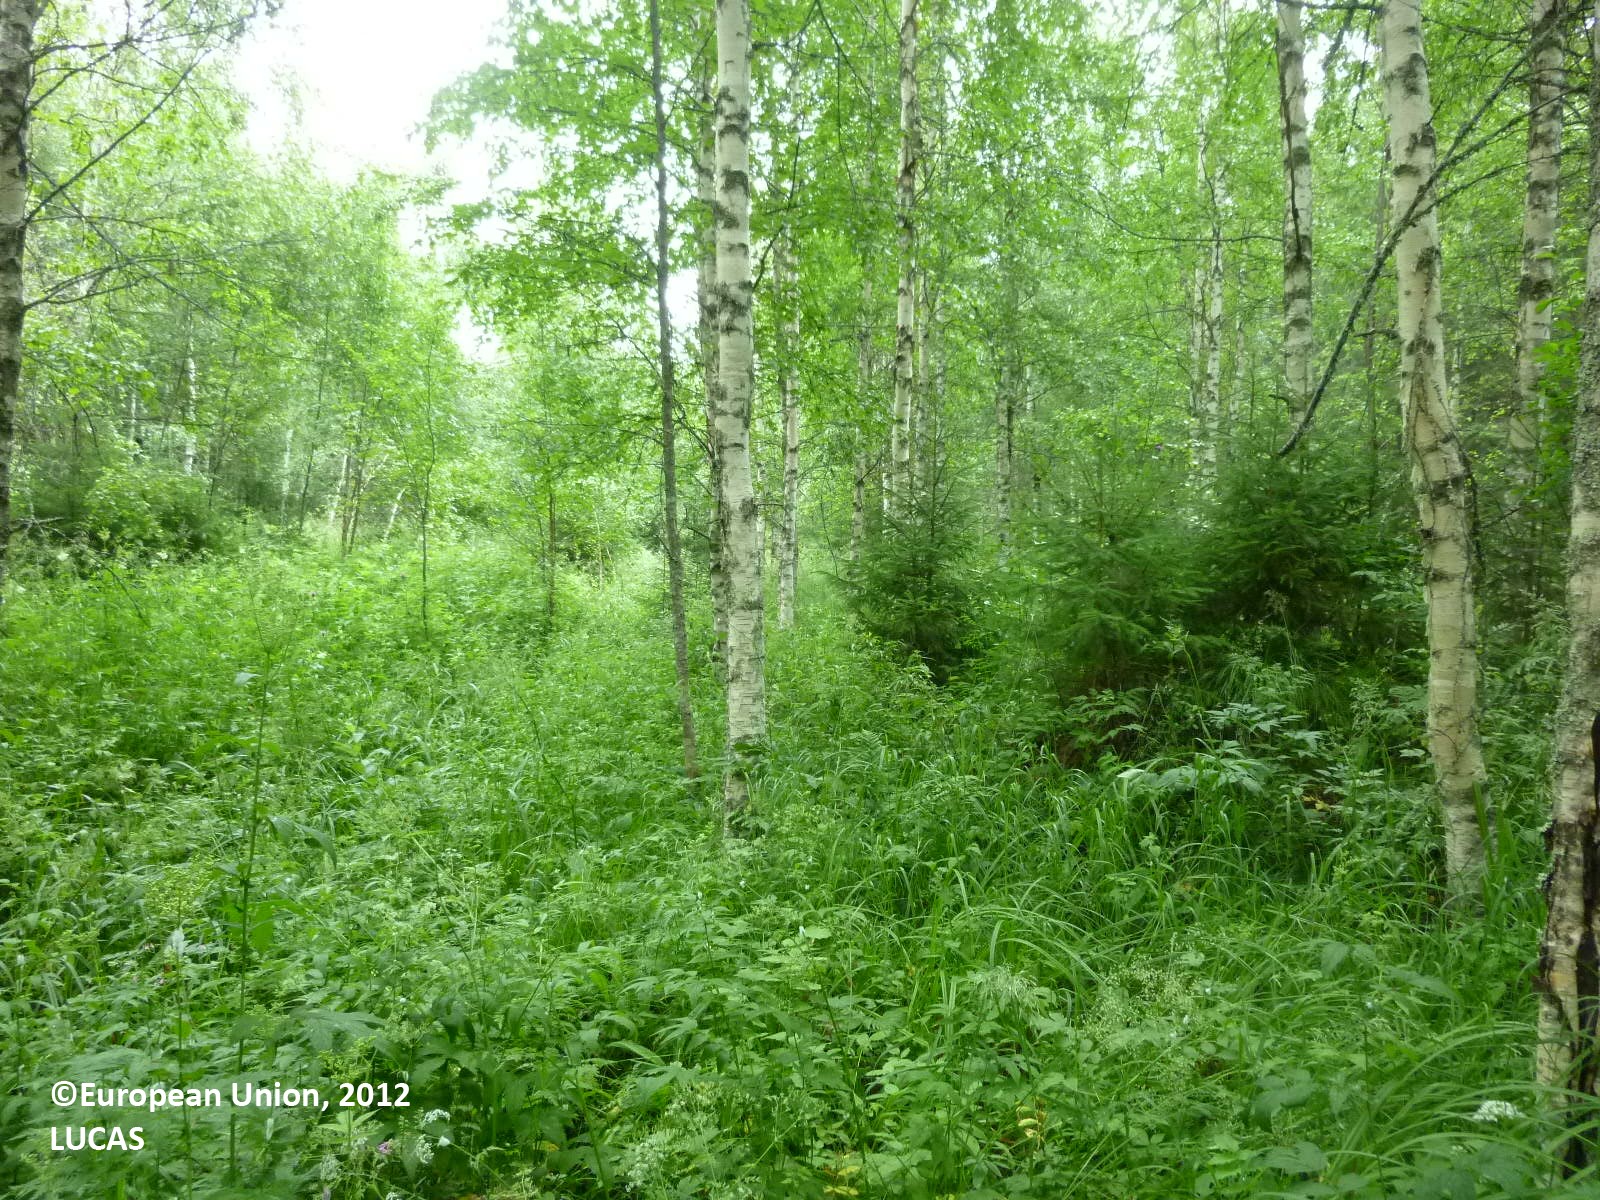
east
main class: Woodland
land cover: Broadleaved woodland
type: boreal forest
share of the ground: > 75 %
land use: Forestry
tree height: > 5 m
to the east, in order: Broadleaved woodland; Ditches and canals; Broadleaved woodland; Tracks; Ditches and canals; Broadleaved woodland; Ditches and canals; Pine dominated coniferous woodland; Ditches and canals; Pine dominated coniferous woodland; Spruce dominated coniferous woodland
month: July
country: FI
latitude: 61.4657
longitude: 22.0870
